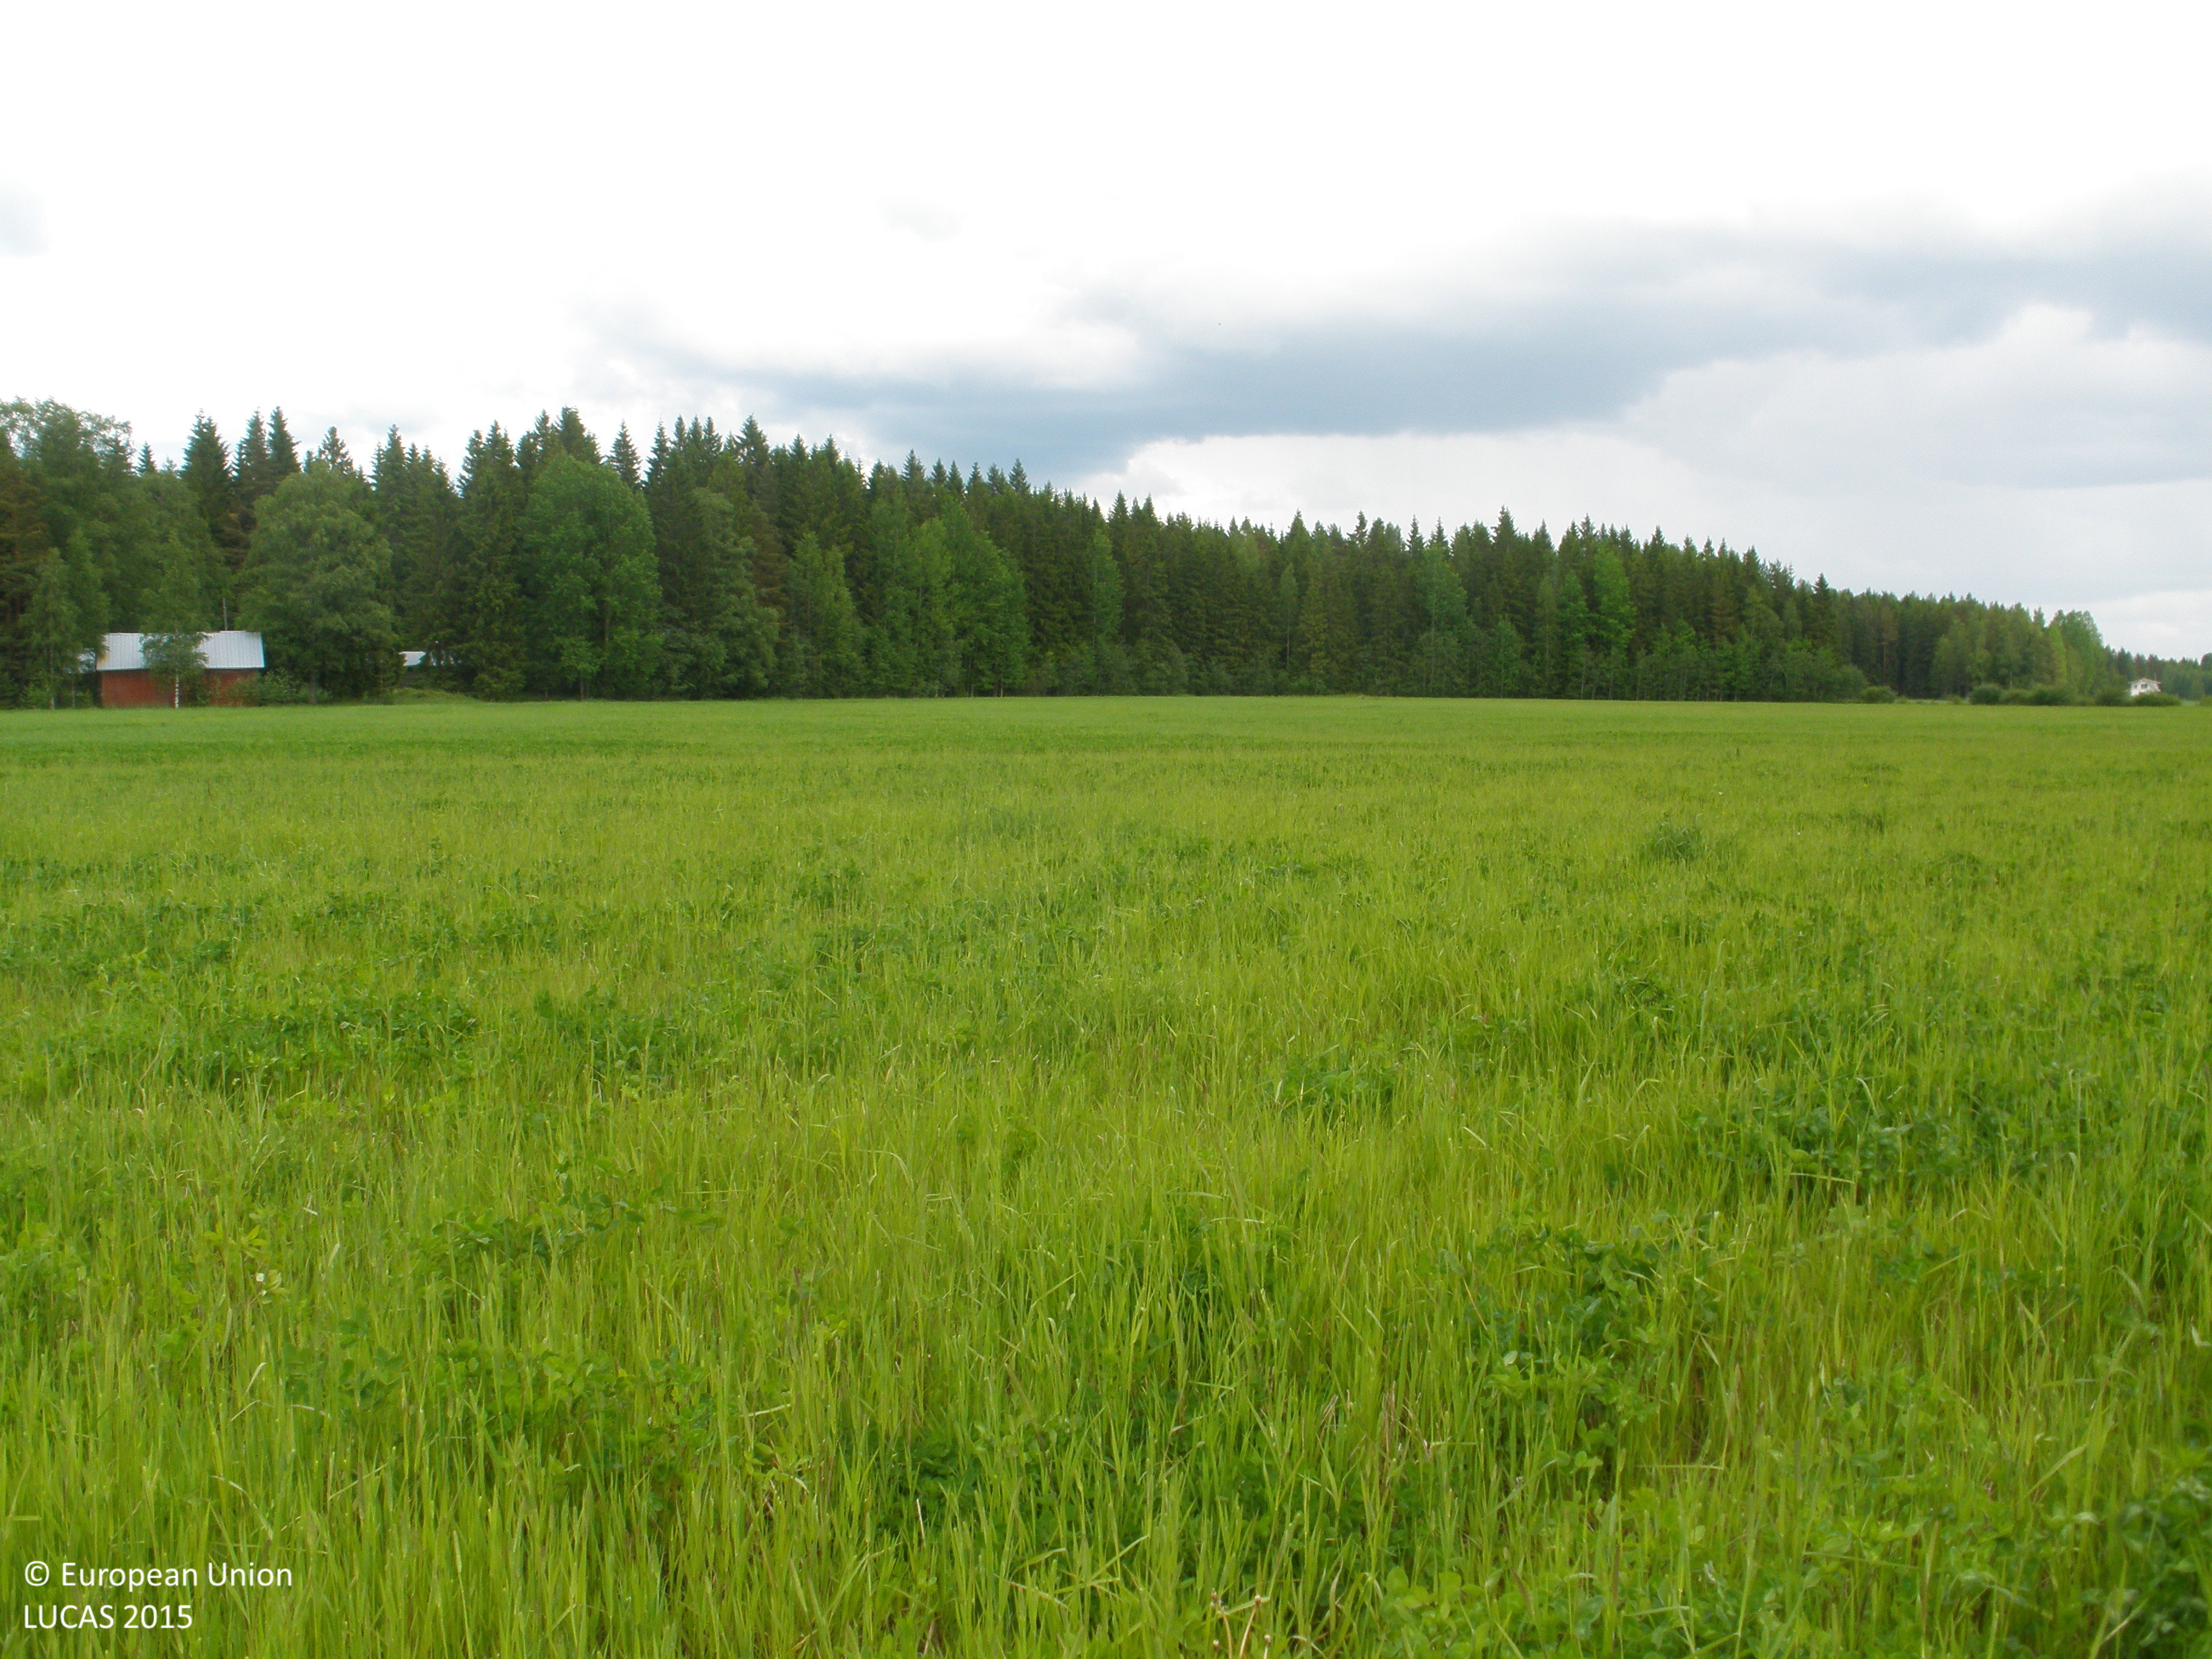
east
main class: Cropland
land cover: Other leguminous and mixtures for fodder
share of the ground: > 75 %
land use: Agriculture (excluding fallow land and kitchen gardens)
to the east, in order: Other leguminous and mixtures for fodder; Grass margins; Rape and turnip rape; Spruce dominated mixed woodland
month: June
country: FI
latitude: 61.0671
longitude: 23.2908
